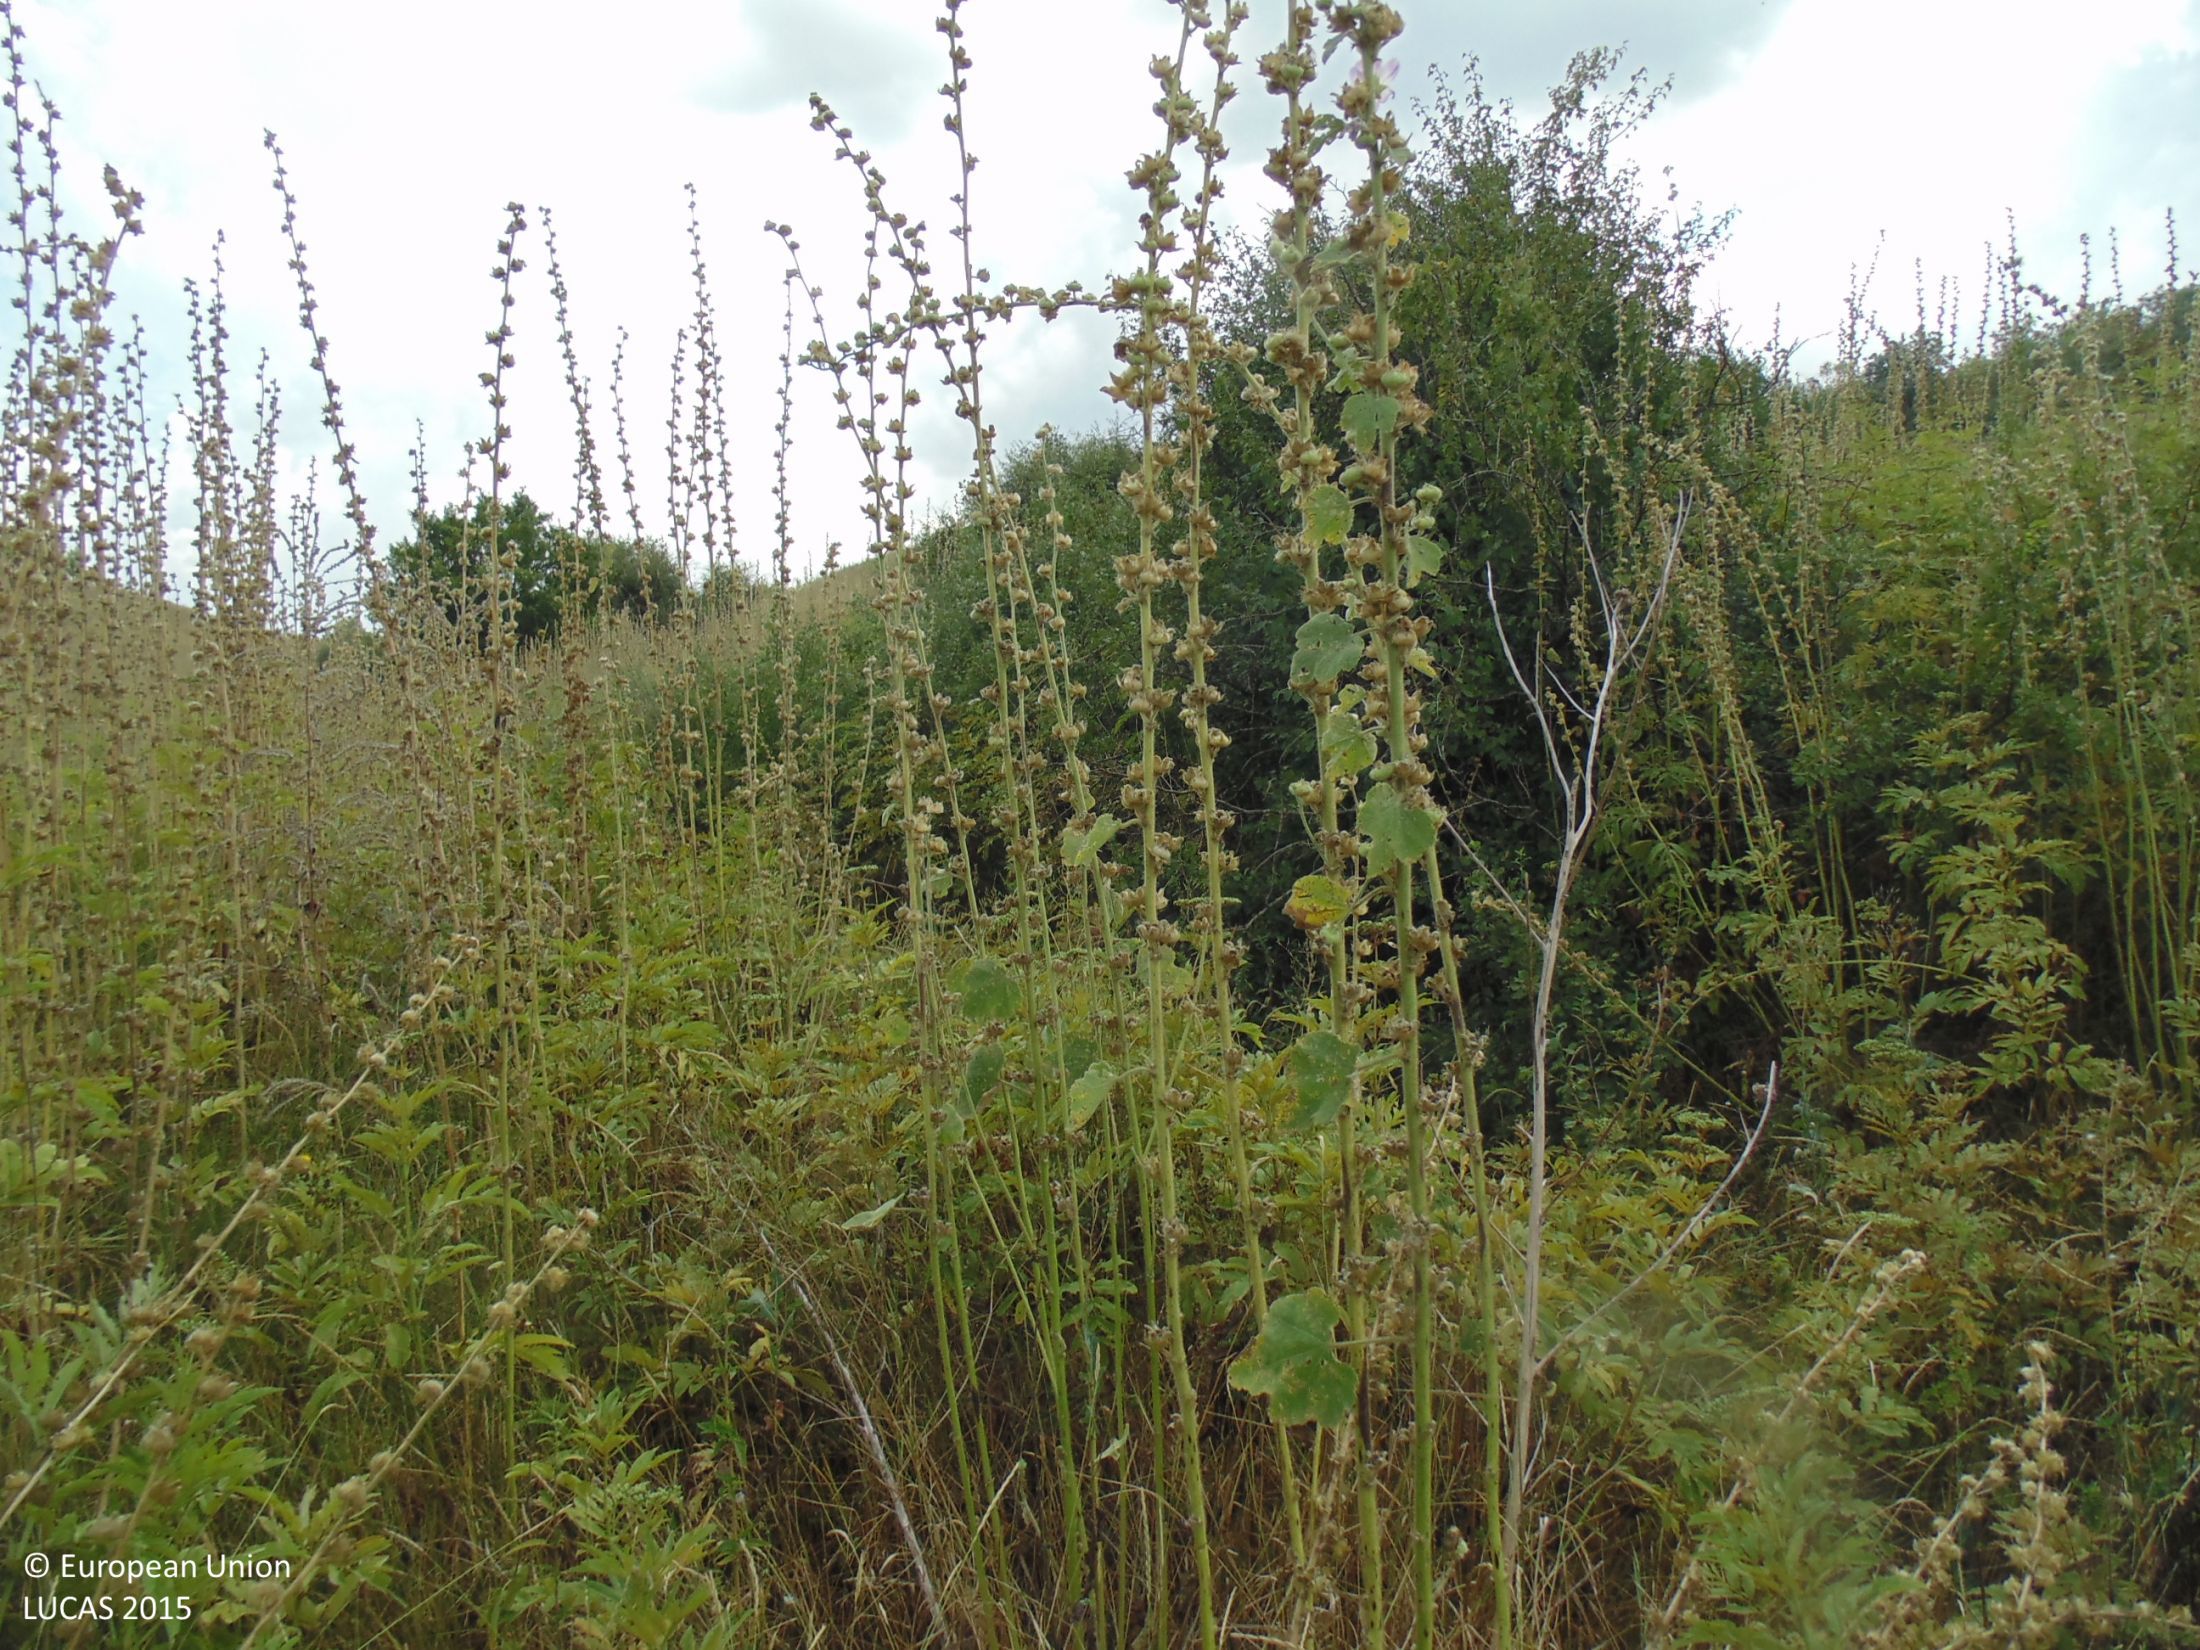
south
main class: Grassland
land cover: Grassland with sparse tree/shrub cover
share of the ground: > 75 %
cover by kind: herbaceous plants 85 %, shrubs 10 %, broadleaved forest trees 5 %
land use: Semi-natural and natural areas not in use
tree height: < 5 m
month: August
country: BG
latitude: 43.8830
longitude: 27.8061
